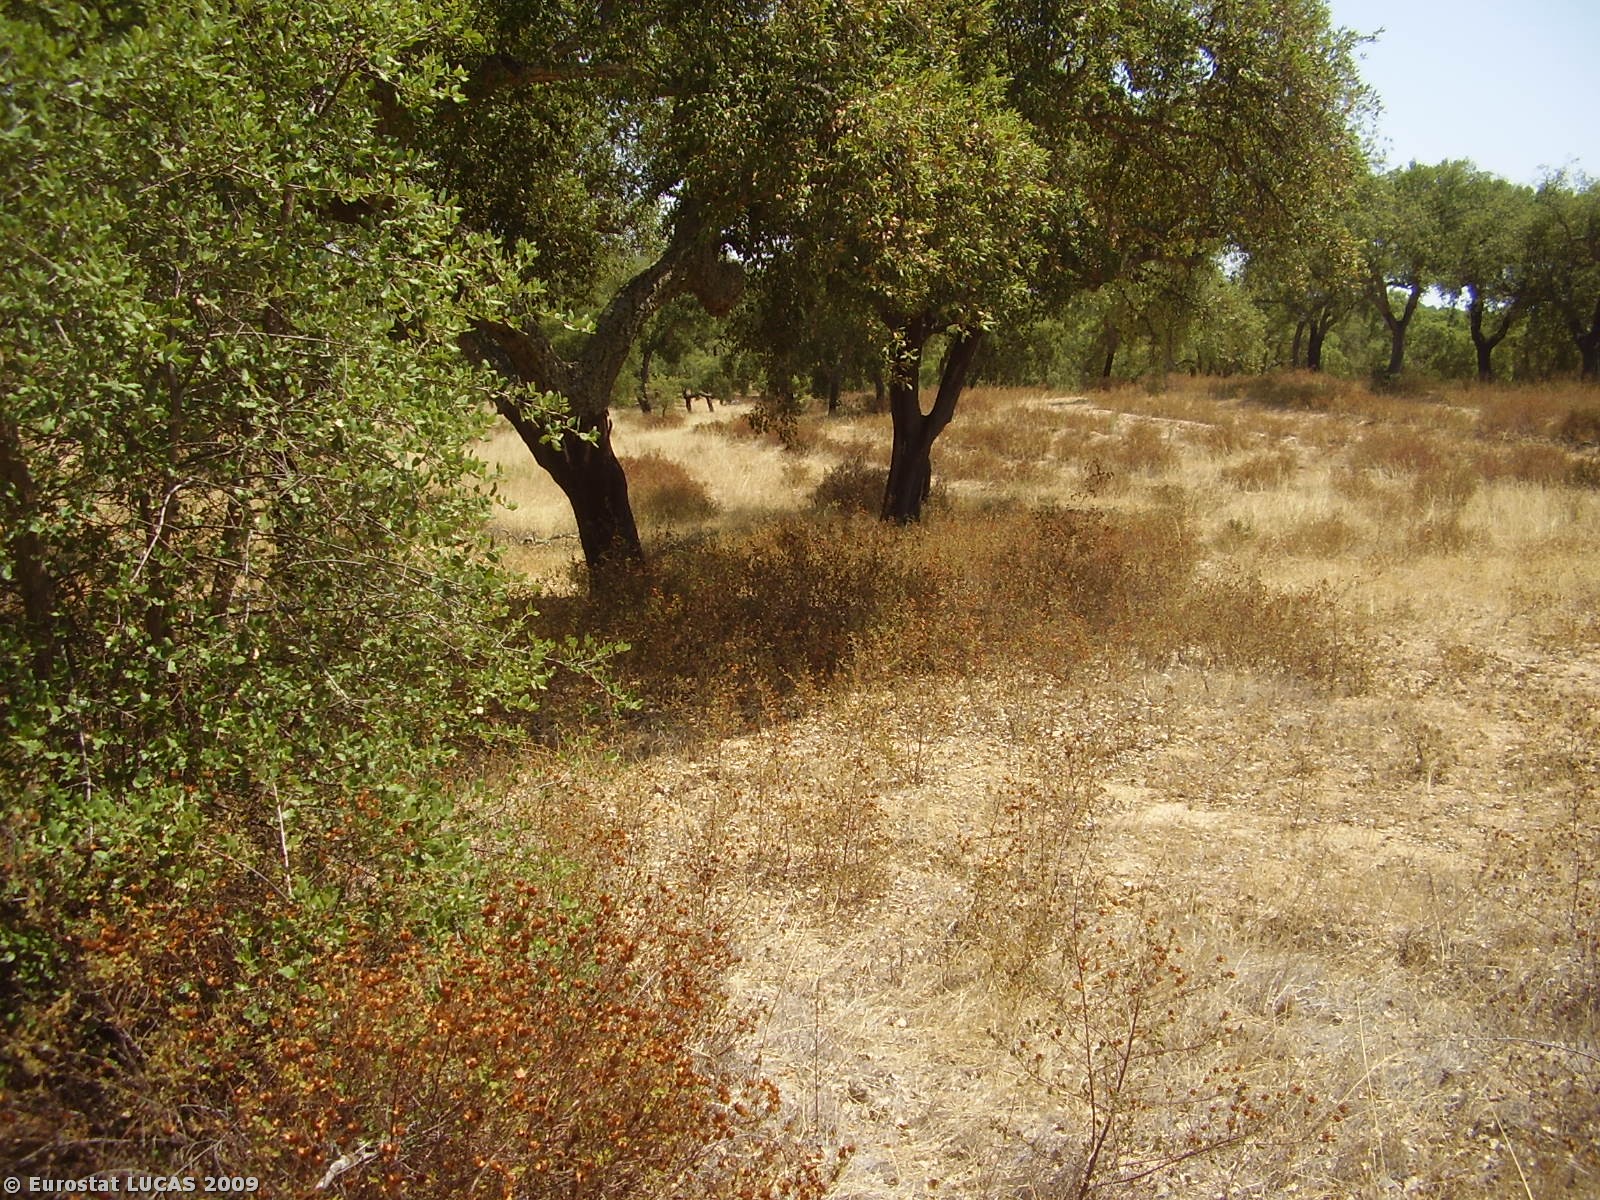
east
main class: Woodland
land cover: Broadleaved woodland
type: broadleaved evergreen forest
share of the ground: 25 - 50 %
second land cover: Shrubland with sparse tree cover
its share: 10 - 25 %
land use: Forestry
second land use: Fallow land
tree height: > 5 m
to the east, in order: Broadleaved woodland; Shrubland with sparse tree cover; Broadleaved woodland; Electric lines; Broadleaved woodland
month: August
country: PT
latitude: 38.2071
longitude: -7.8583
